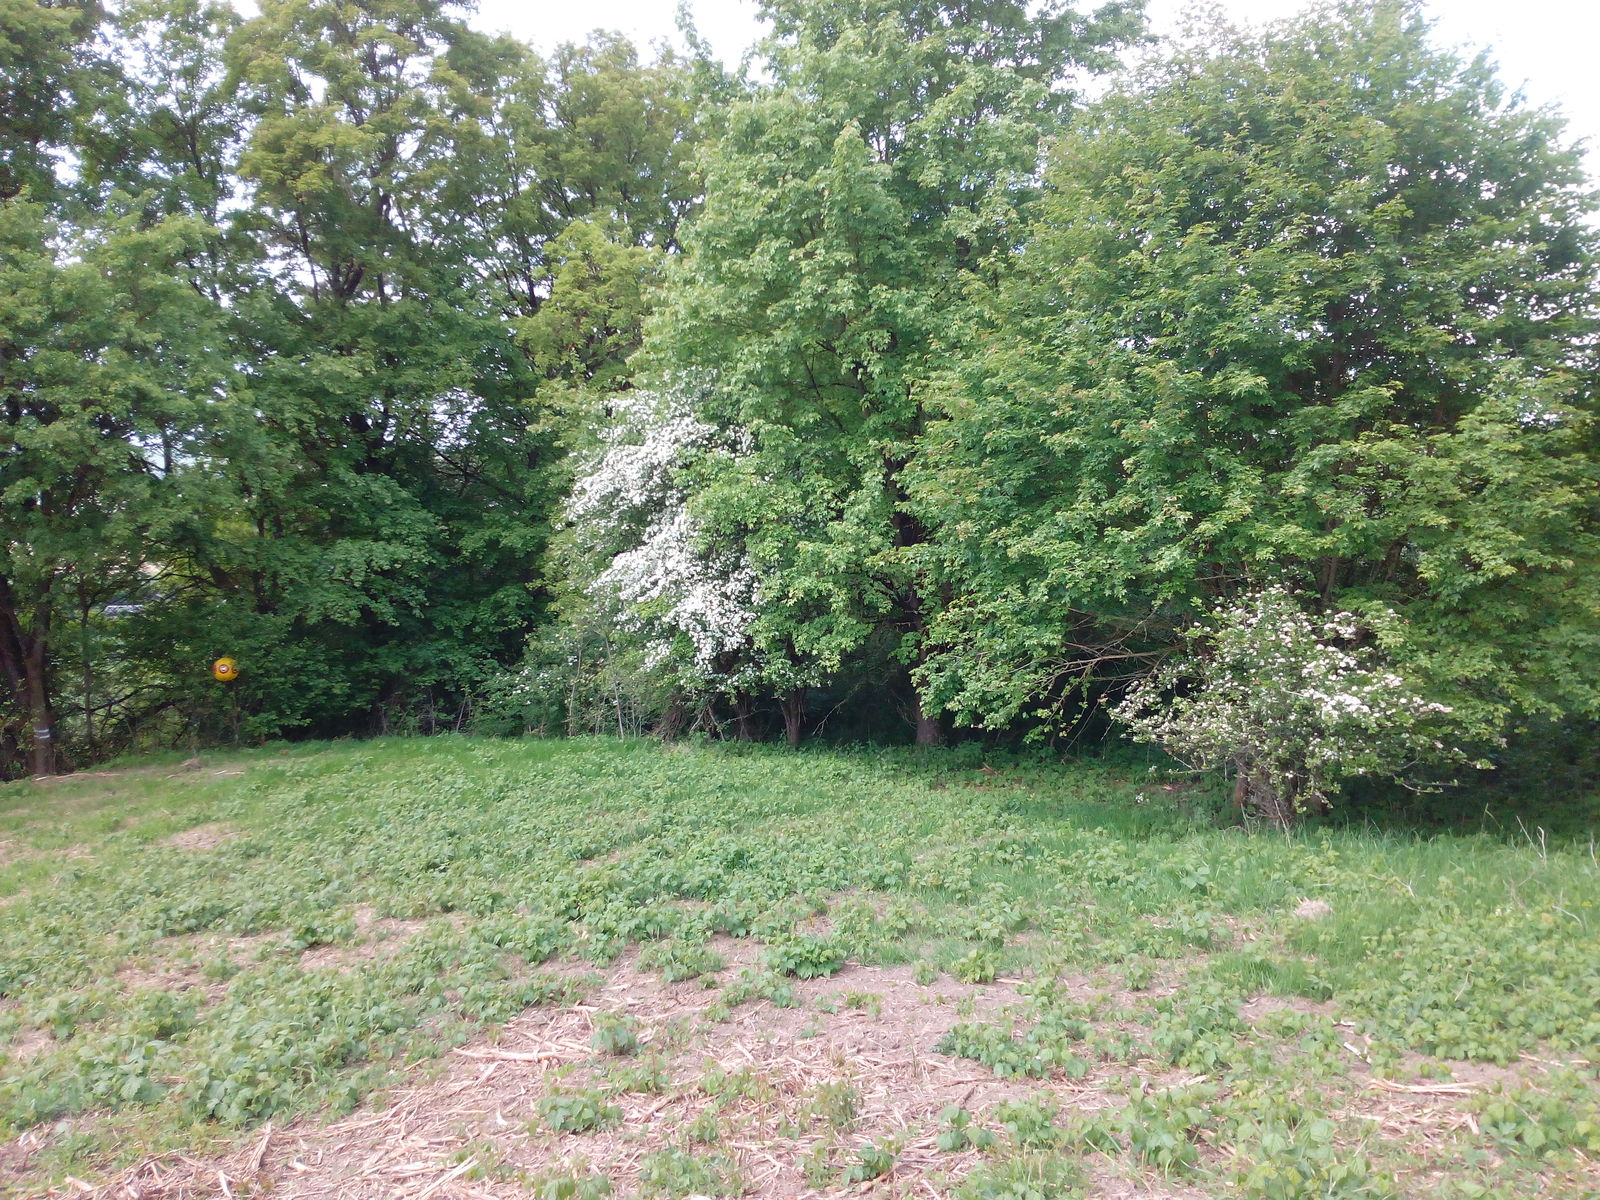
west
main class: Grassland
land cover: Grassland with sparse tree/shrub cover
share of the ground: 50 - 75 %
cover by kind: herbaceous plants 45 %, unconsolidated bare surface 40 %, shrubs 10 %, broadleaved forest trees 5 %
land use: Abandoned areas
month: May
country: DE
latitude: 50.3954
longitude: 11.0266
